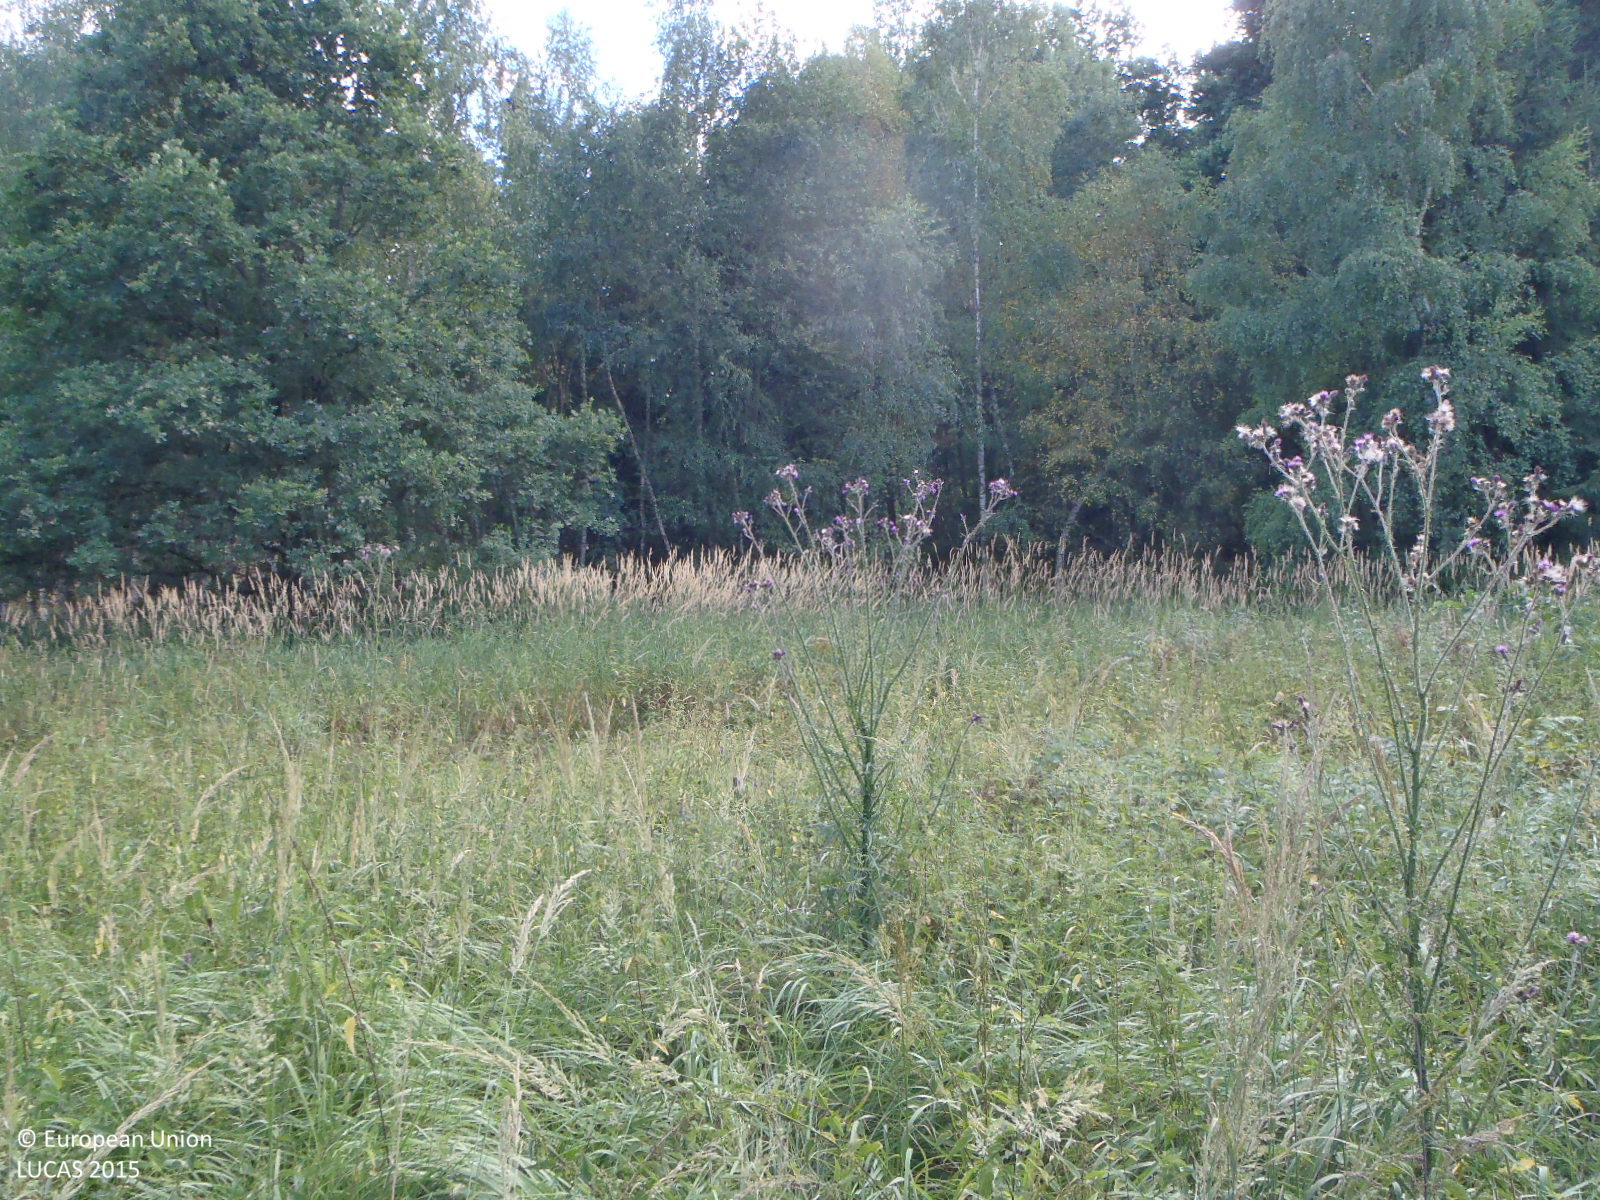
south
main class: Woodland
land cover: Broadleaved woodland
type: non-riverine alder, birch or aspen forest
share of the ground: > 75 %
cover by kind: broadleaved forest trees 100 %
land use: Semi-natural and natural areas not in use
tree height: > 5 m
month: July
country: CZ
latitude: 48.9662
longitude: 14.3583
